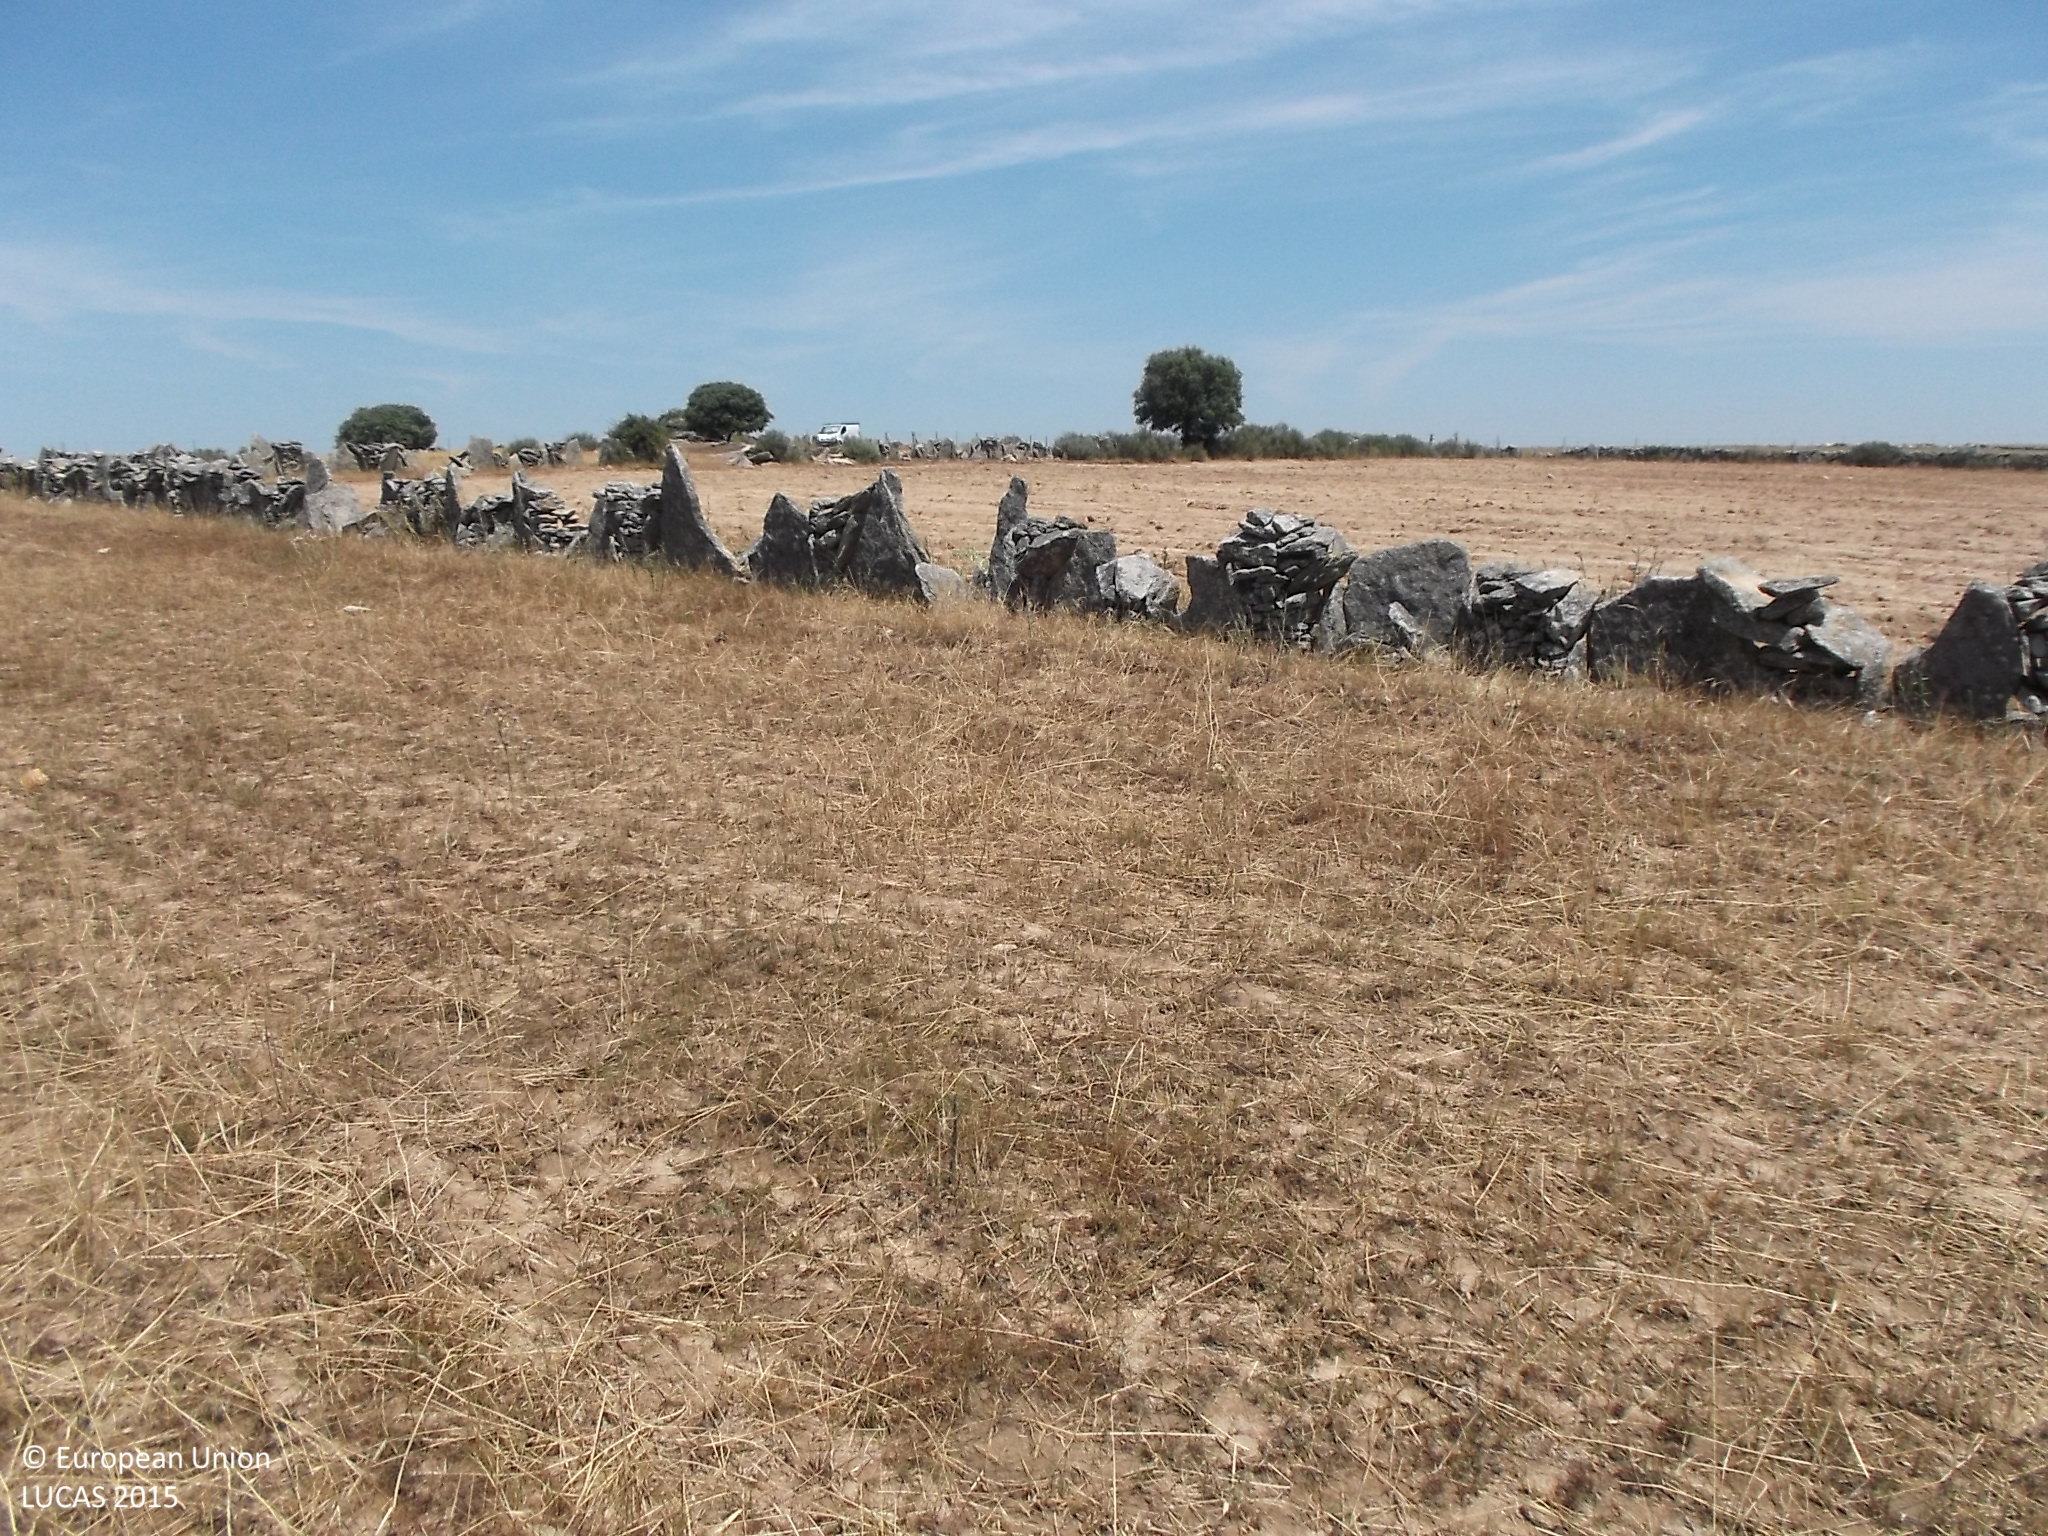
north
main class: Cropland
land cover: Rye
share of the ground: < 10 %
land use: Agriculture (excluding fallow land and kitchen gardens)
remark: Harvested field
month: June
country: ES
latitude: 41.2547
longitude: -6.0457
